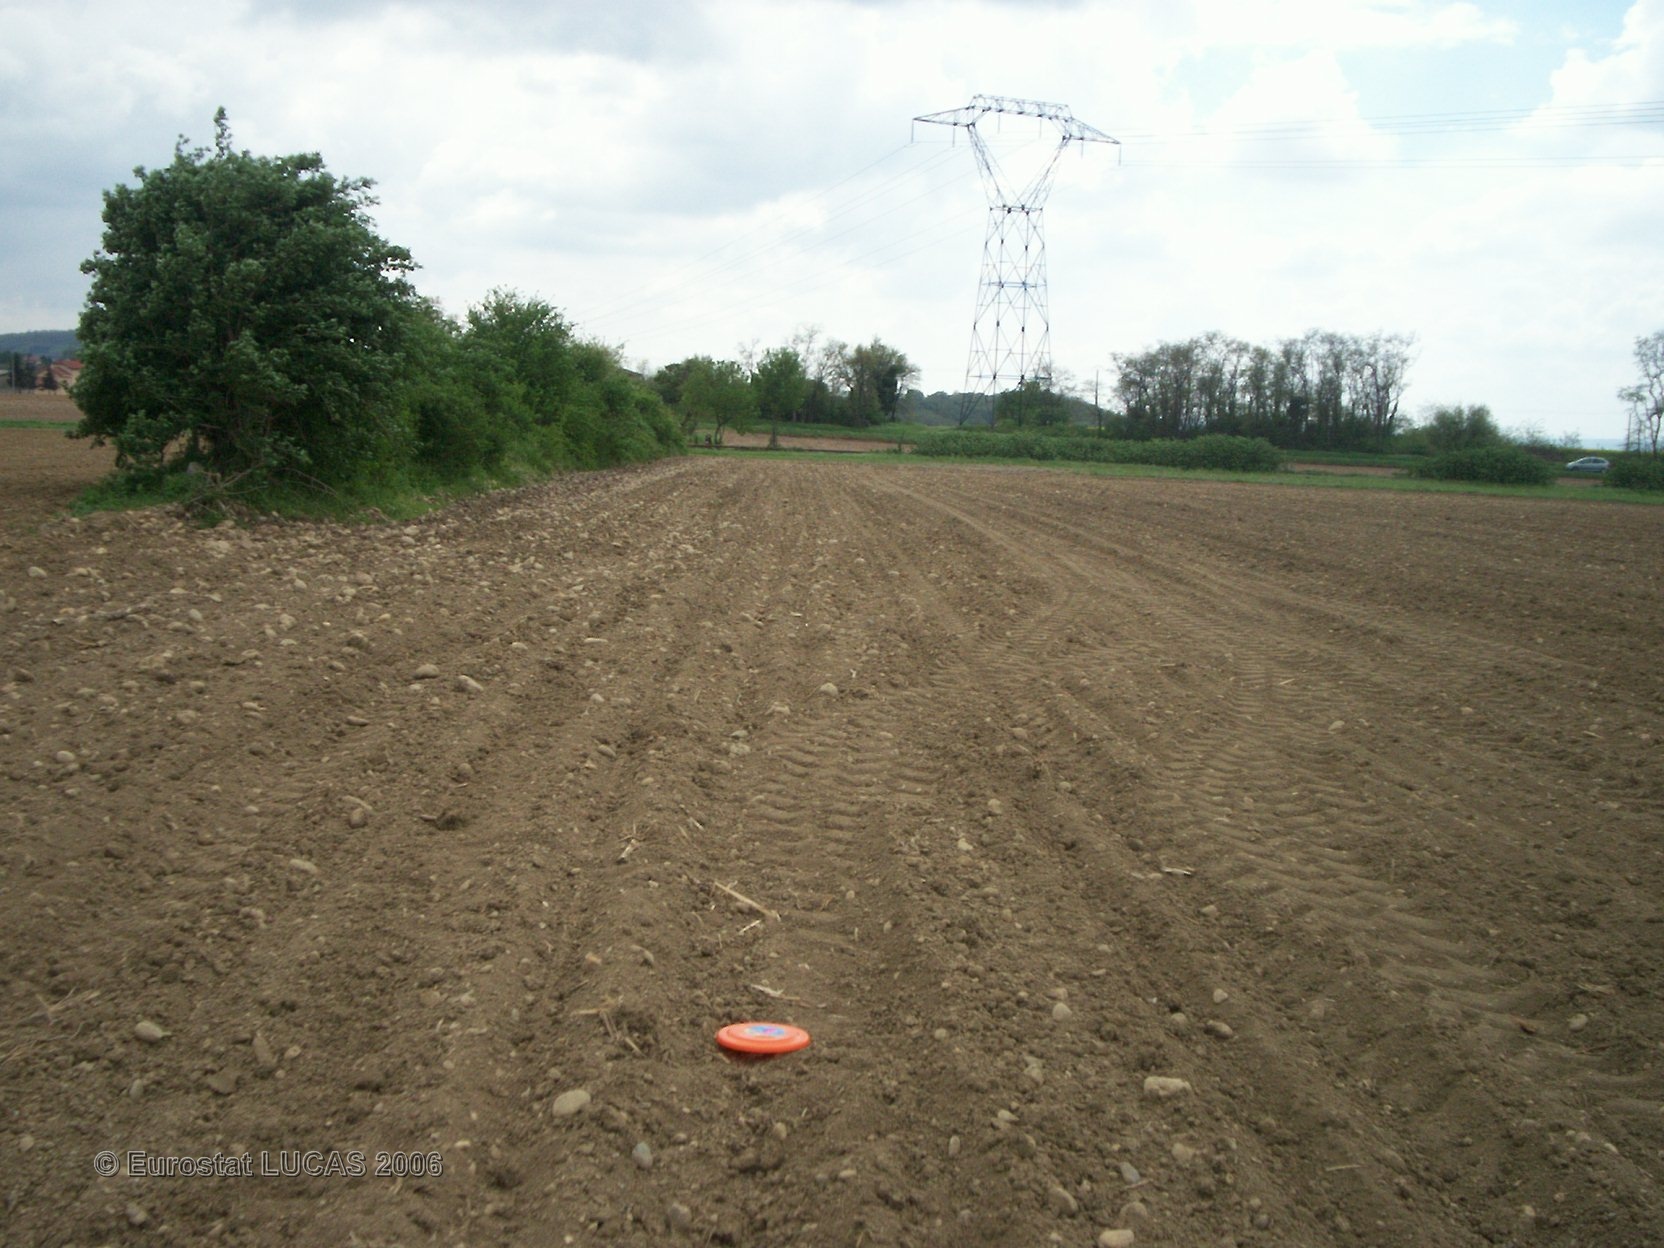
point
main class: Cropland
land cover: Maize
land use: Agriculture (excluding fallow land and kitchen gardens)
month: April
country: FR
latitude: 45.2893
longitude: 4.8664
